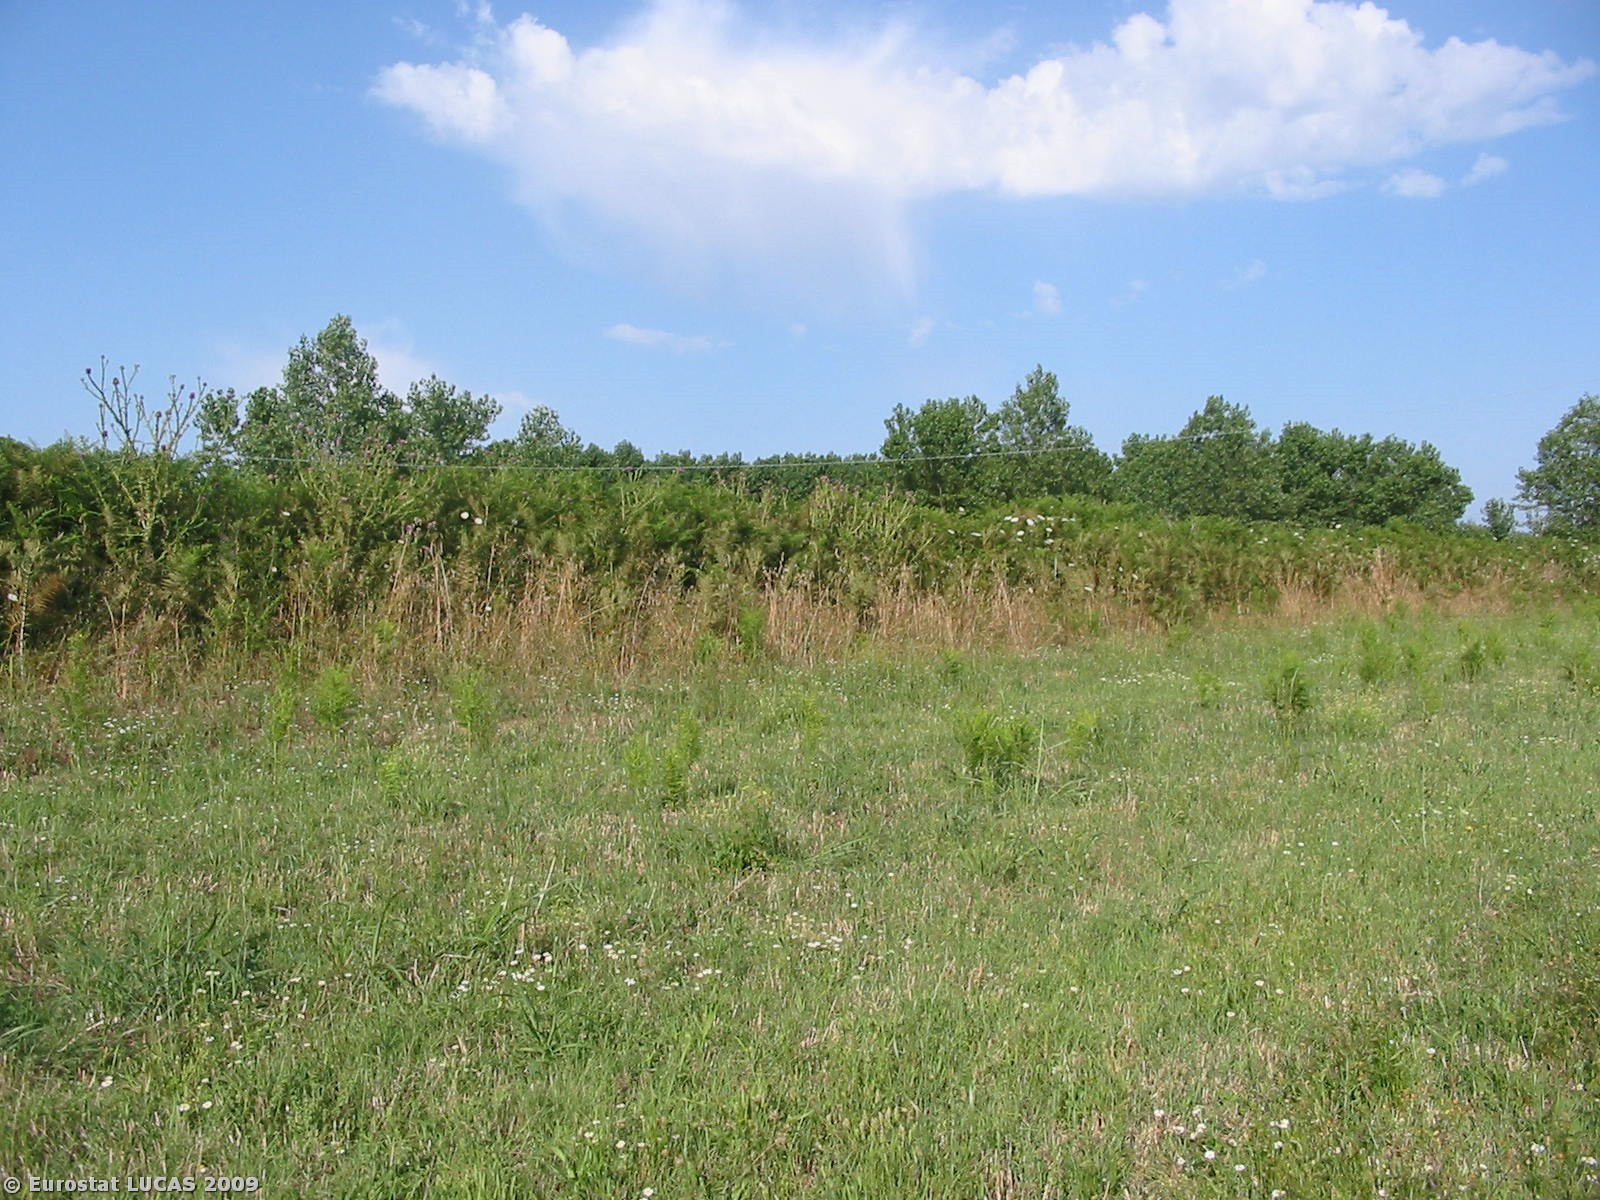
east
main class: Cropland
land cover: Oats
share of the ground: > 75 %
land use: Agriculture (excluding fallow land and kitchen gardens)
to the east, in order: Oats; Fences; Shrubland with sparse tree cover; Electric lines; Shrubland with sparse tree cover; Ditches and canals; Grassland without tree/shrub cover
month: July
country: IT
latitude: 38.6144
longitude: 15.9724
